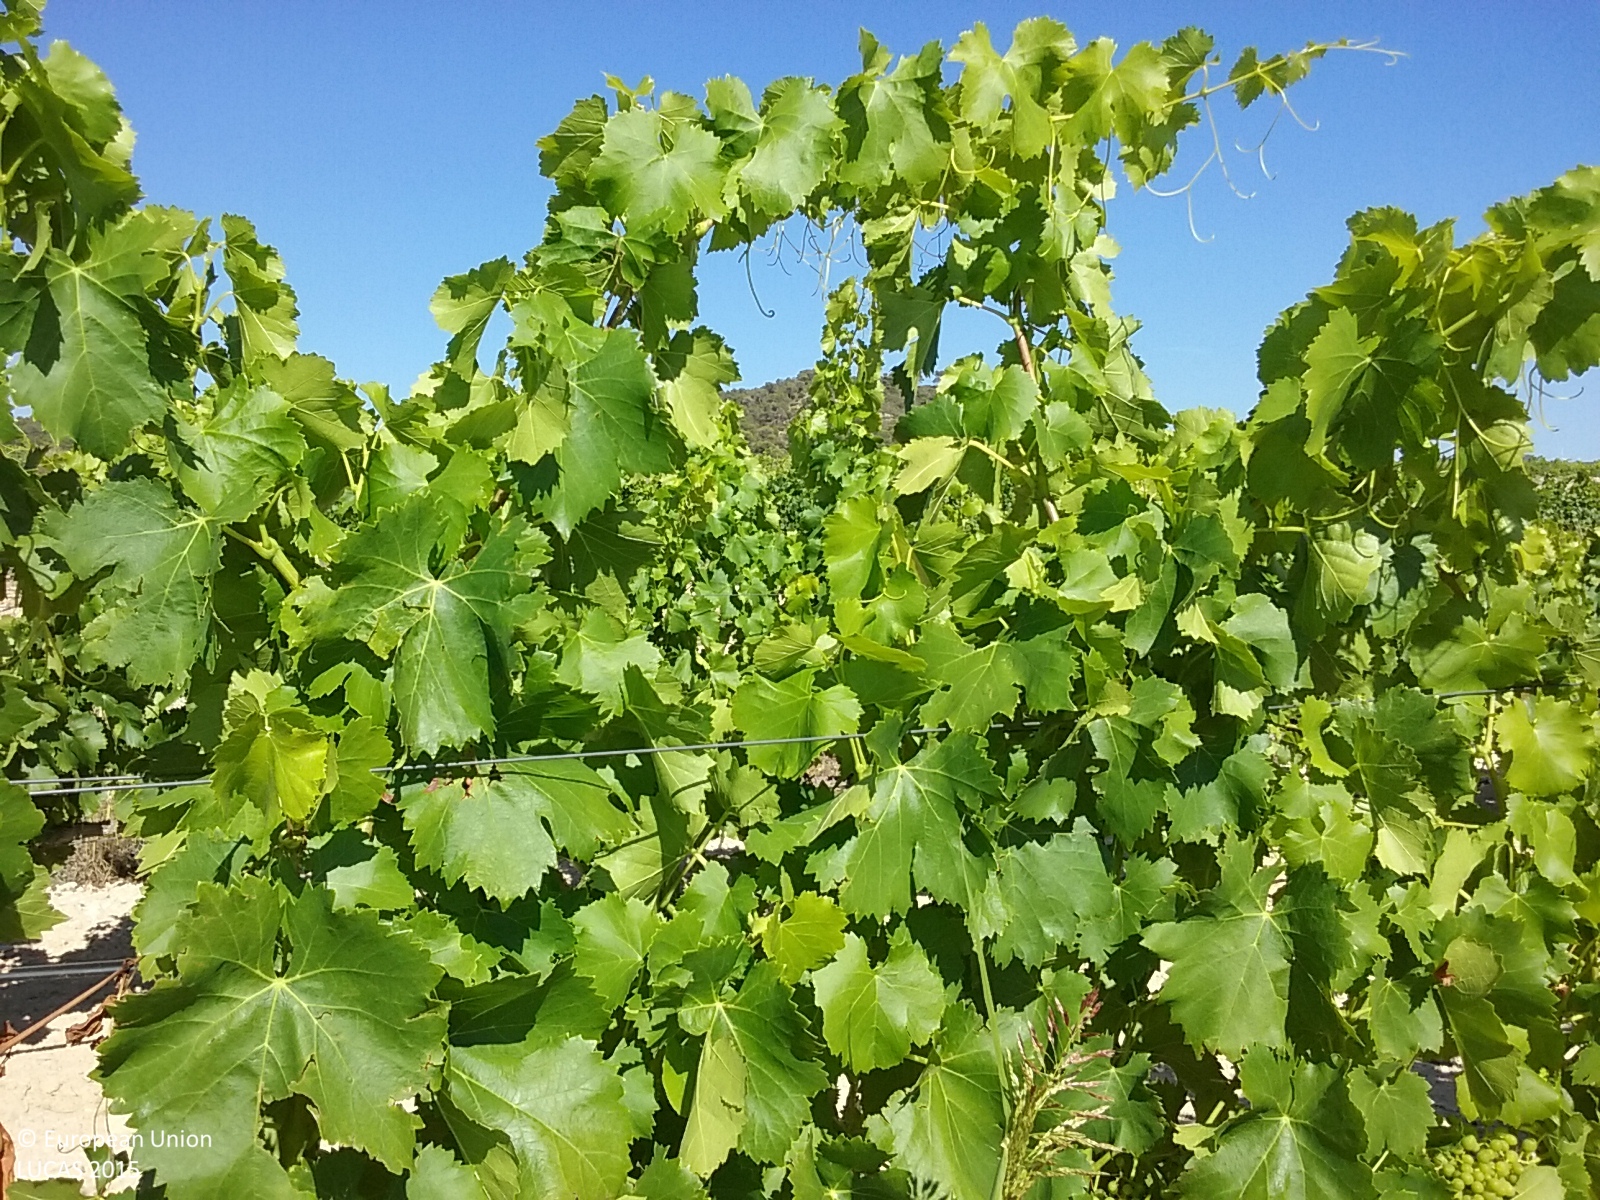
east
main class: Cropland
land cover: Vineyards
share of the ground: 10 - 25 %
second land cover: Other bare soil
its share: > 75 %
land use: Agriculture (excluding fallow land and kitchen gardens)
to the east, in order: Vineyards; Other bare soil; Tracks; Vineyards; Grass margins; Vineyards; Artificial constructions; Grass margins; Vineyards; Grass margins; Vineyards
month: June
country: ES
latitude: 41.1060
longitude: 0.2138
